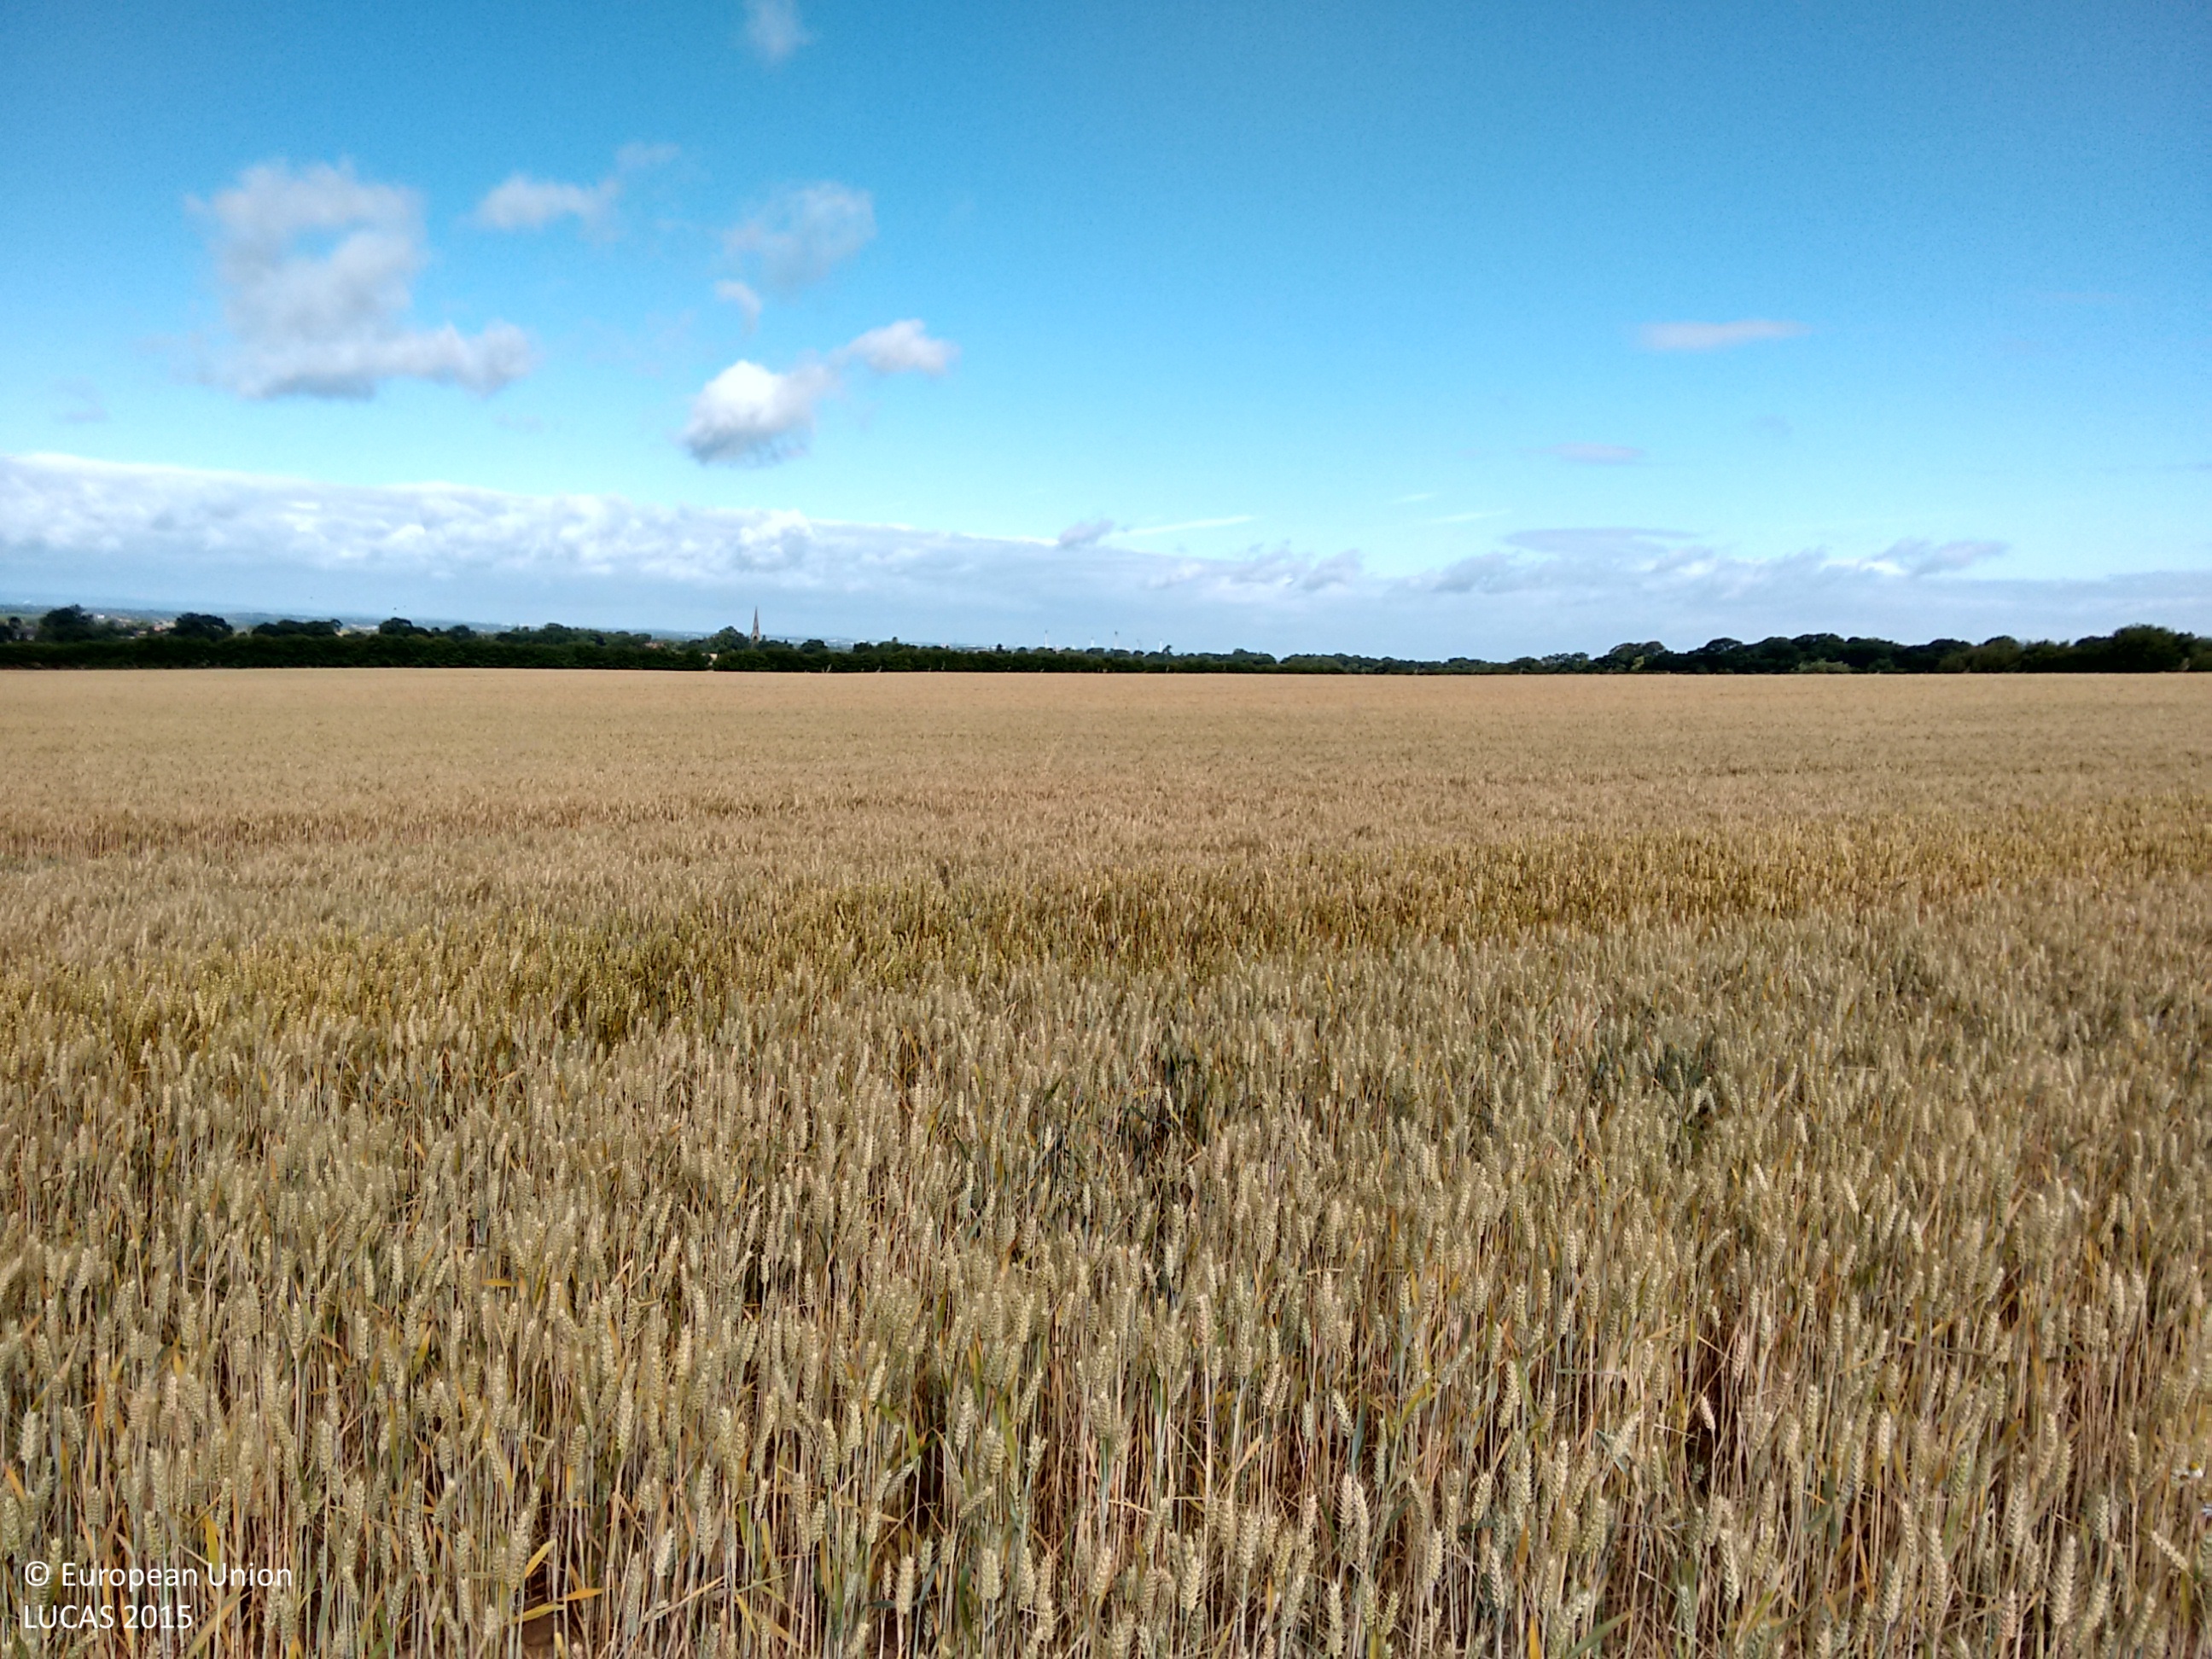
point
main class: Cropland
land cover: Common wheat
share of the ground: > 75 %
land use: Agriculture (excluding fallow land and kitchen gardens)
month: July
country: GB
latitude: 53.2189
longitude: -2.7247
